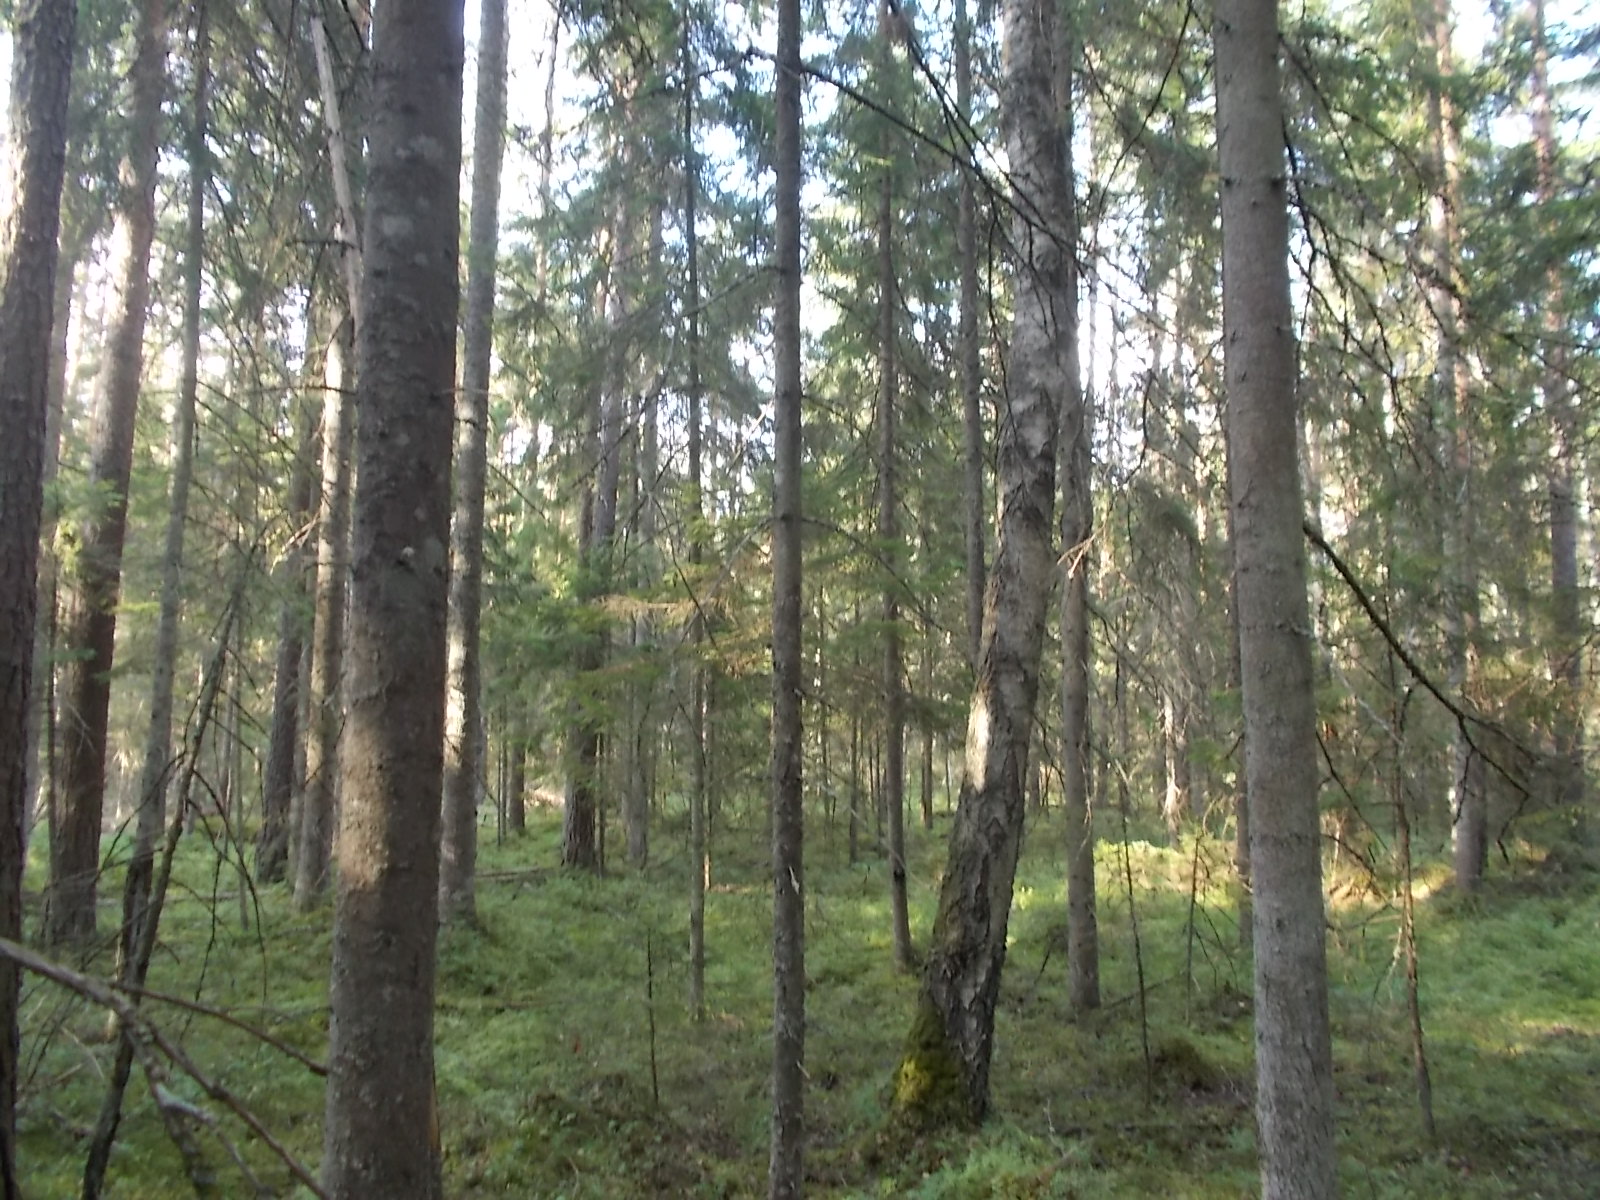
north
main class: Woodland
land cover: Other coniferous woodland
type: hemiboreal forest and nemoral coniferous forest and mixed broadleaved-coniferous forest
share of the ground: 50 - 75 %
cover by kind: coniferous forest trees 70 %, broadleaved forest trees 10 %, shrubs 10 %, herbaceous plants 10 %
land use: Forestry
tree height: > 5 m
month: August
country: LV
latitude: 57.1016
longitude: 21.7472
